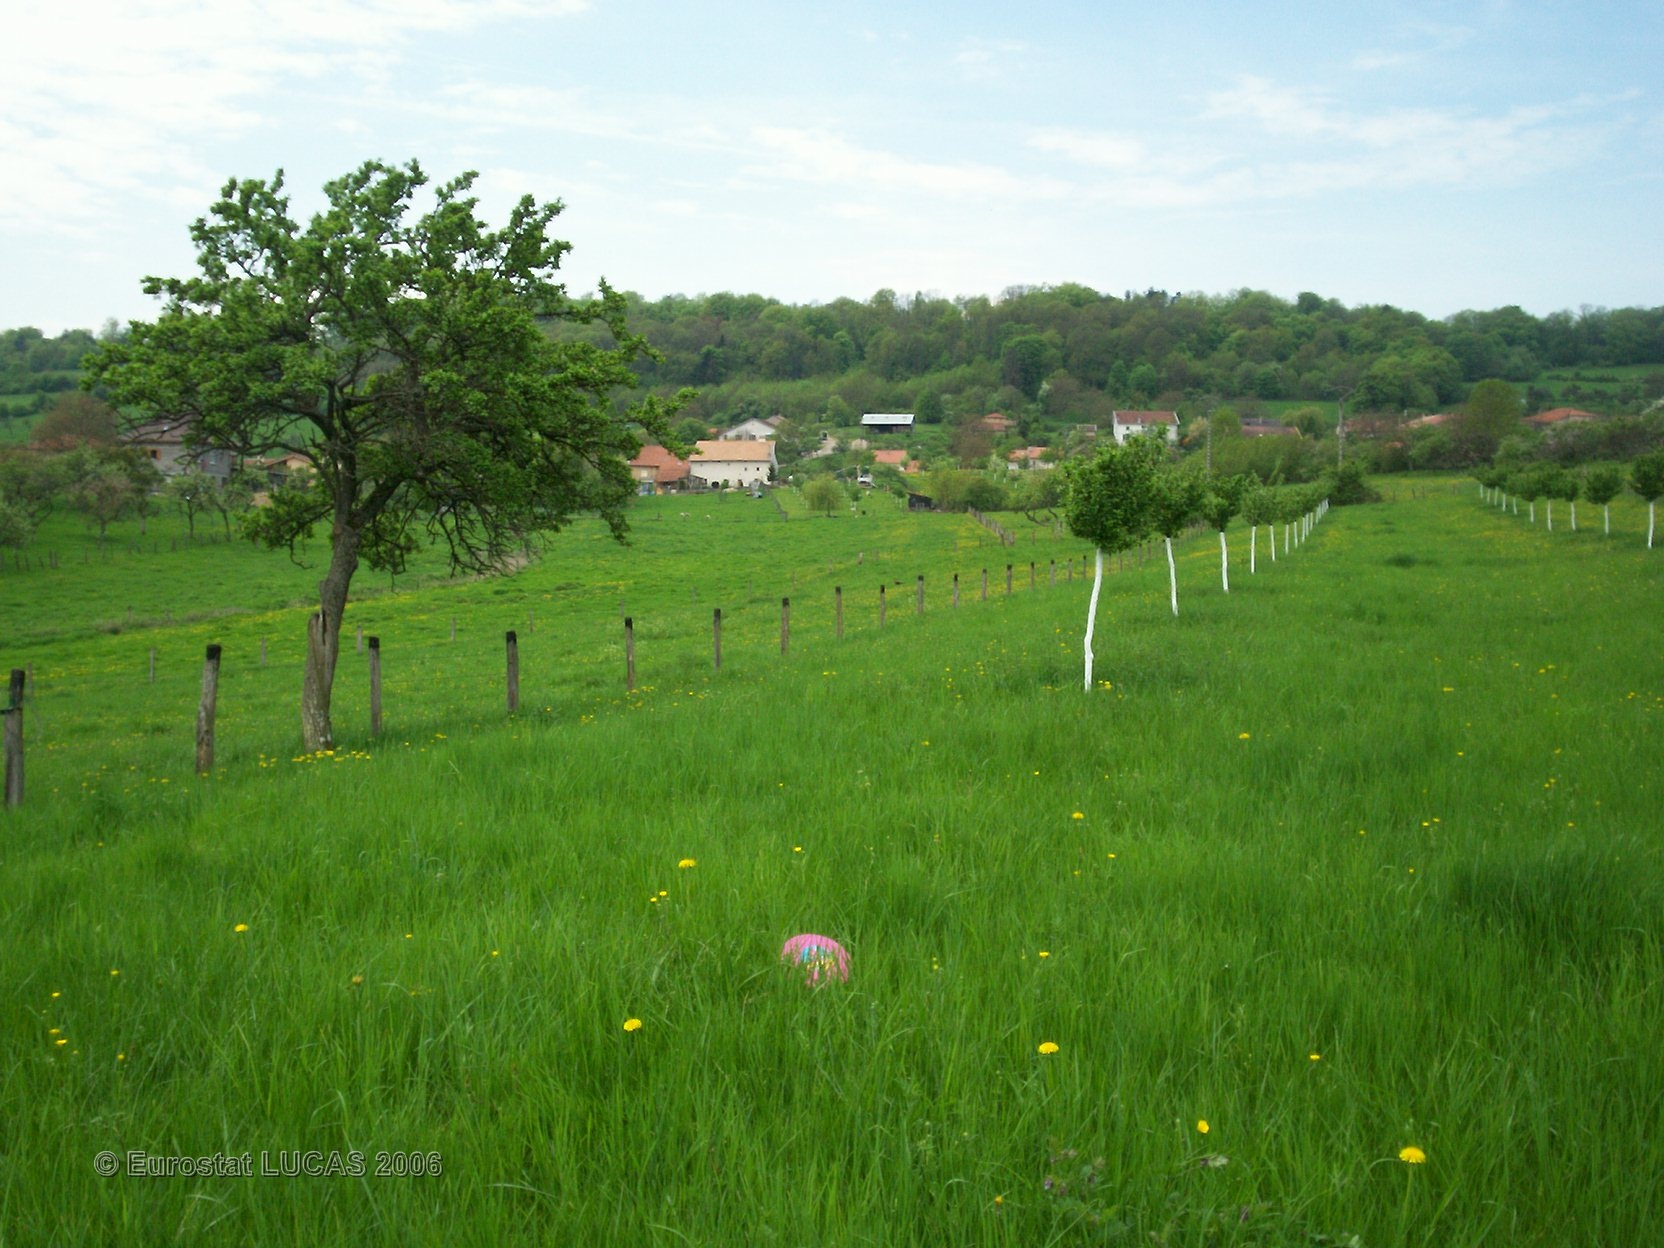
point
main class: Cropland
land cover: Other fruit trees and berries
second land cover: Grassland with sparse tree/shrub cover
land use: Agriculture (excluding fallow land and kitchen gardens)
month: May
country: FR
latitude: 48.4926
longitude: 5.9810
